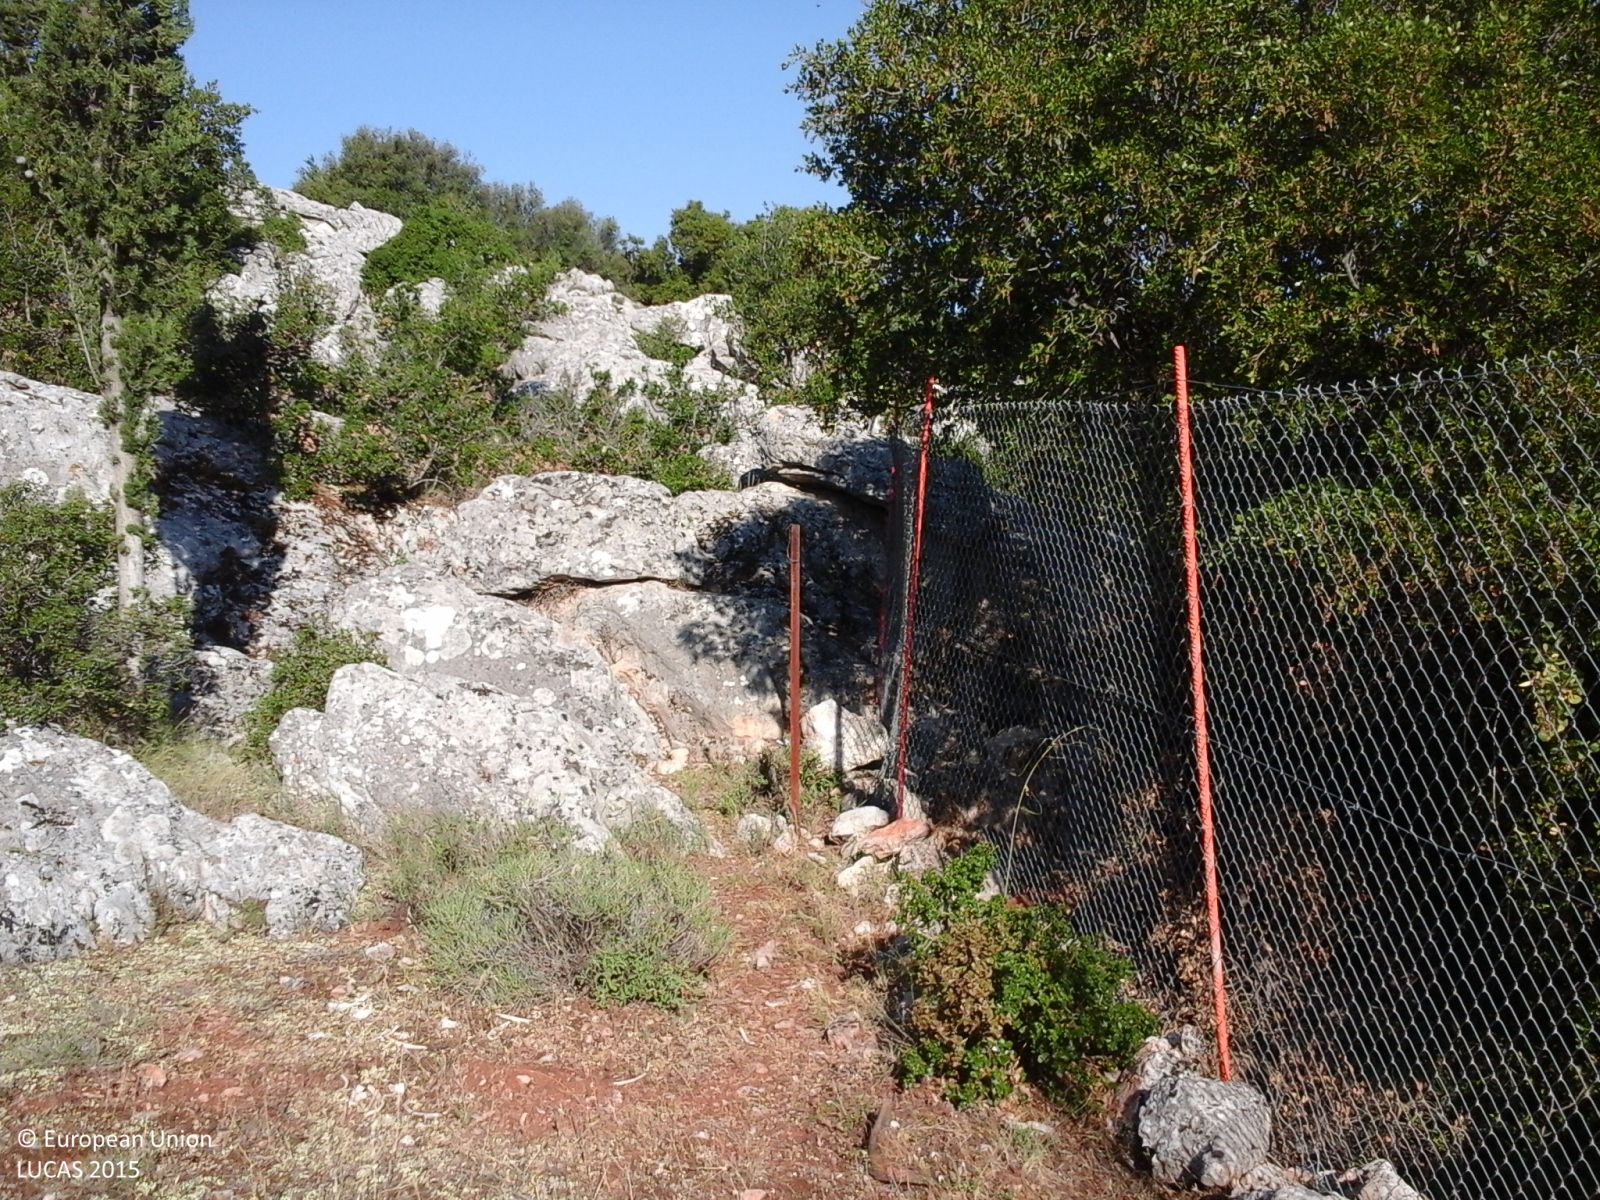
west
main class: Shrubland
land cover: Shrubland without tree cover
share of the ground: 50 - 75 %
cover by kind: shrubs 60 %, herbaceous plants 20 %, unconsolidated bare surface 20 %
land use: Agriculture (excluding fallow land and kitchen gardens)
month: June
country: GR
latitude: 38.4193
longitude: 22.5169
